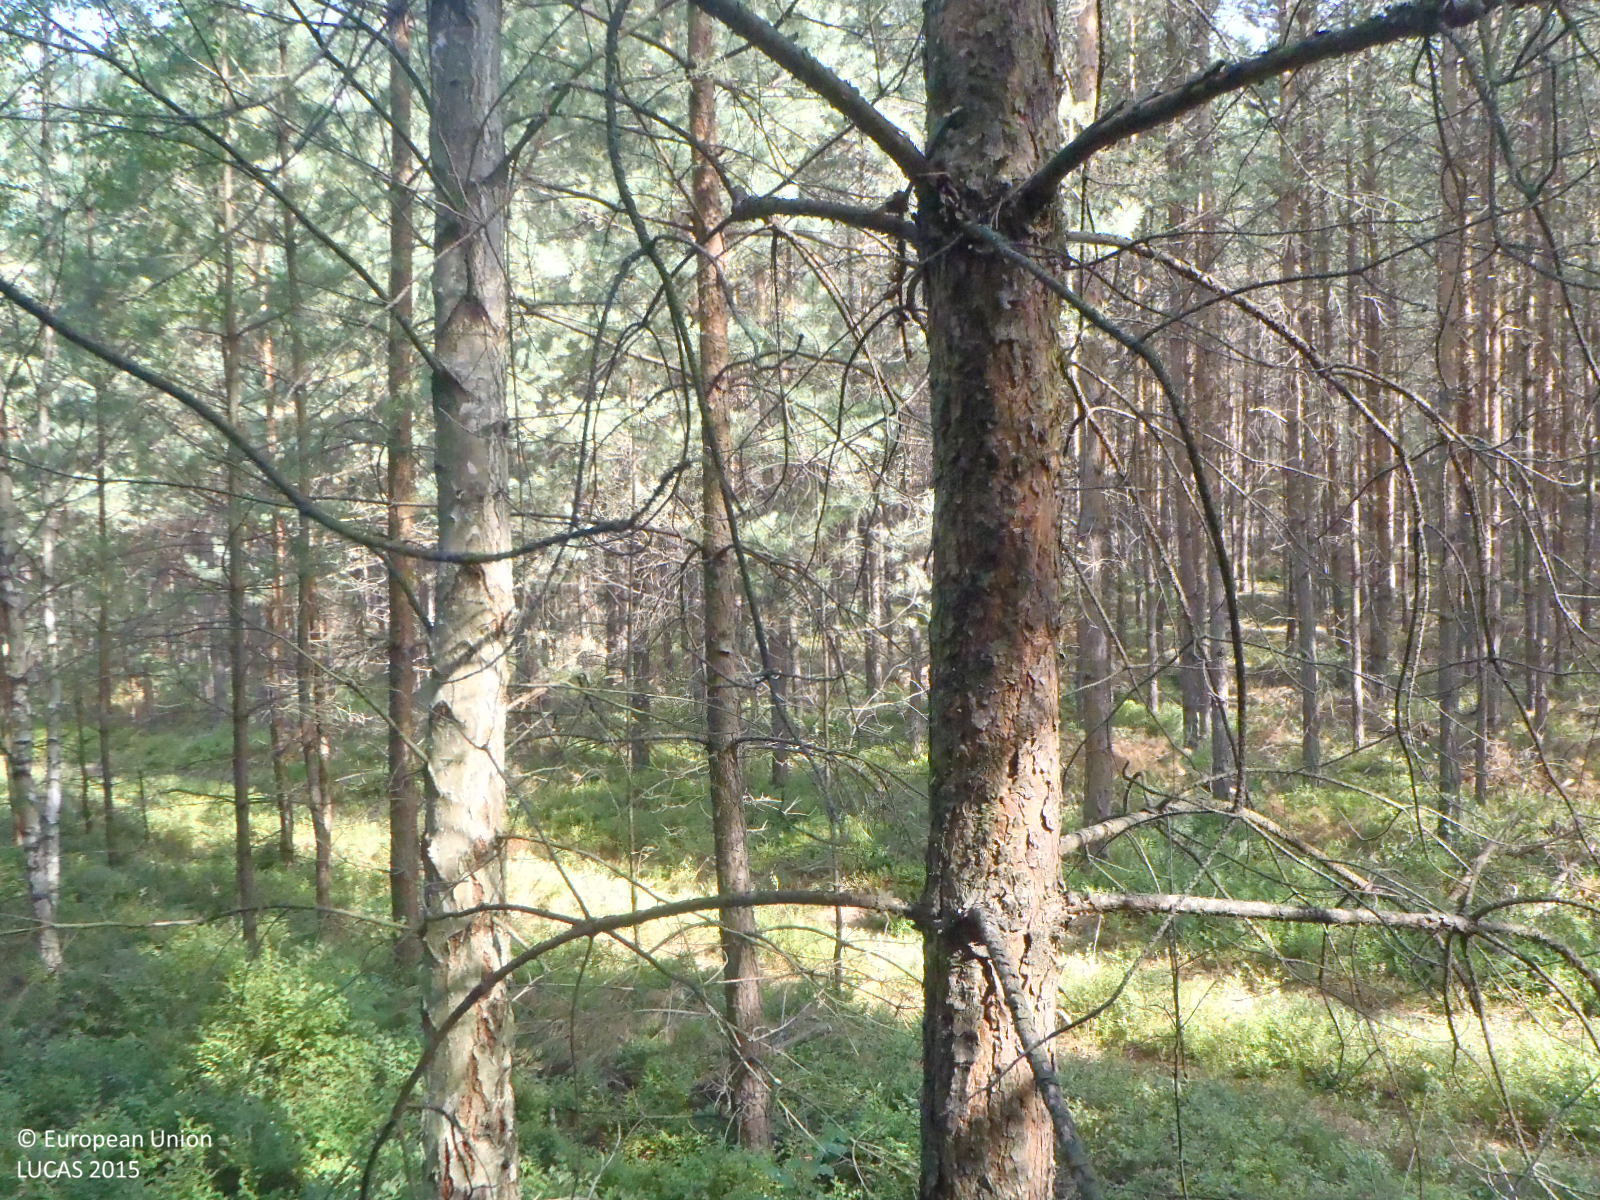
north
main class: Woodland
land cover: Pine dominated coniferous woodland
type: hemiboreal forest and nemoral coniferous forest and mixed broadleaved-coniferous forest
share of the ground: > 75 %
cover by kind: coniferous forest trees 85 %, broadleaved forest trees 10 %, herbaceous plants 5 %
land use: Forestry
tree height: > 5 m
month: August
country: CZ
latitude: 50.6510
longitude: 14.5703
